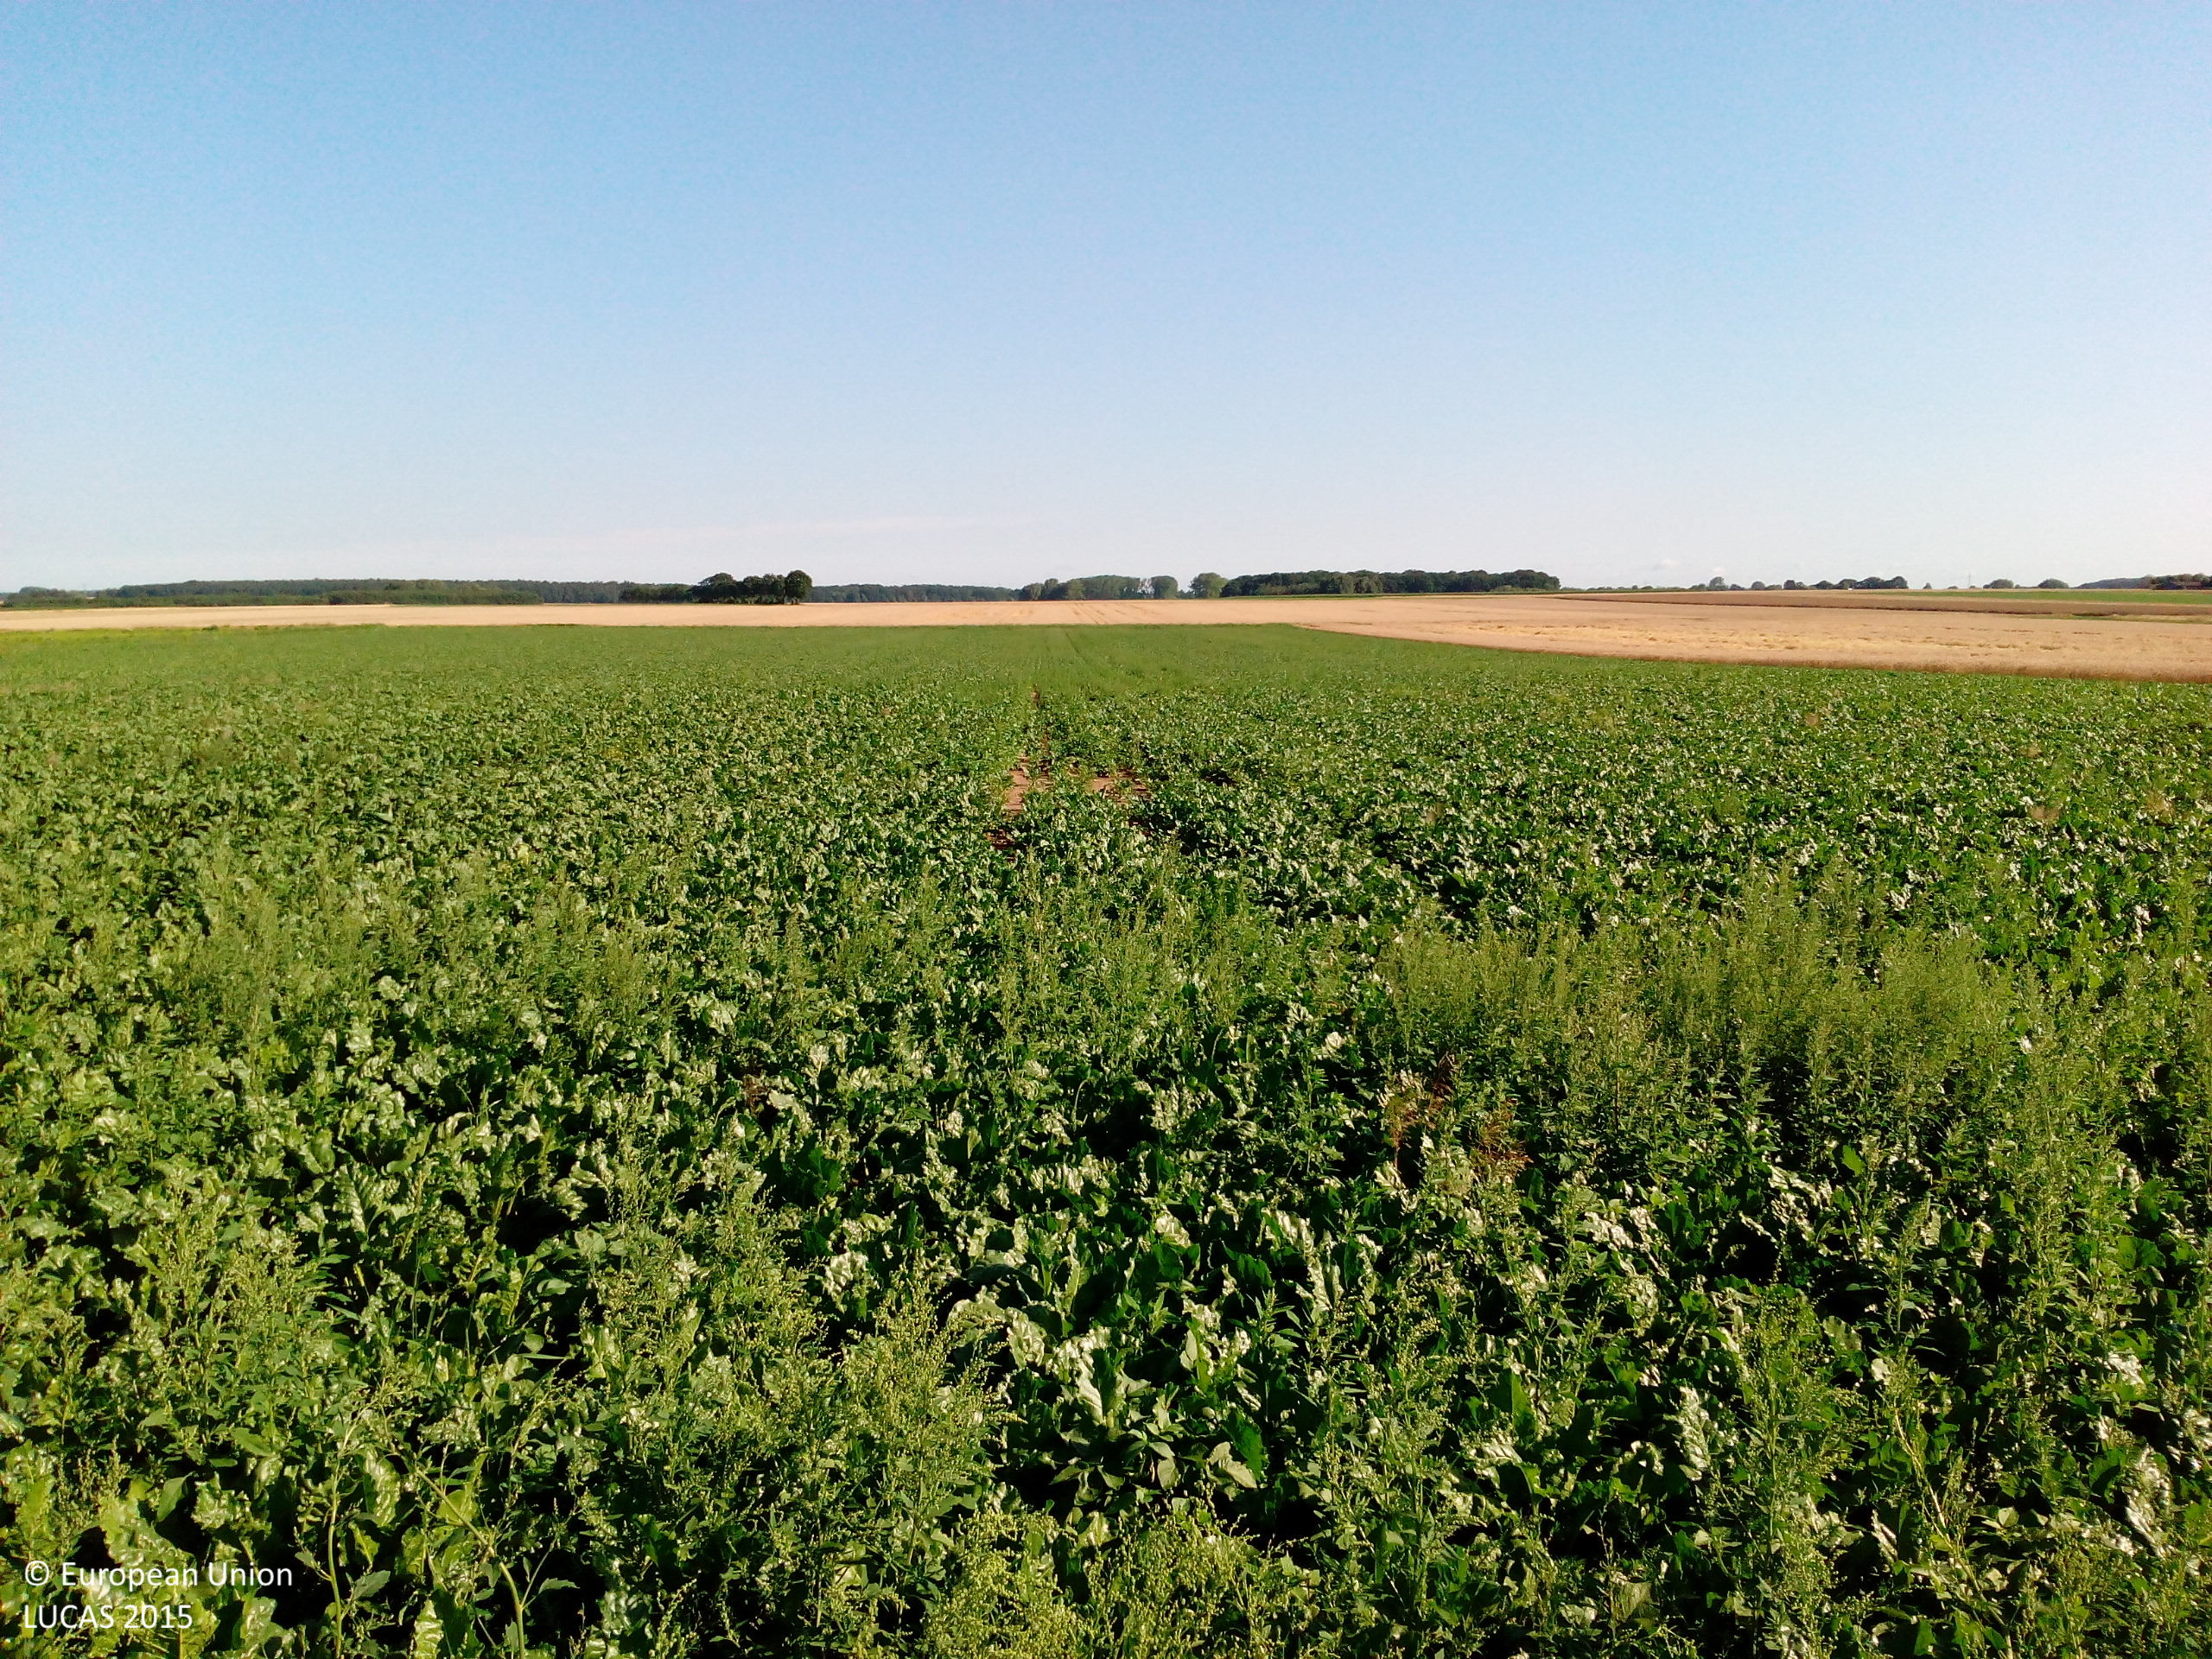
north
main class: Cropland
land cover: Sugar beet
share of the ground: > 75 %
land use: Agriculture (excluding fallow land and kitchen gardens)
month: July
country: DE
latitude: 52.3412
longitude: 10.2788
